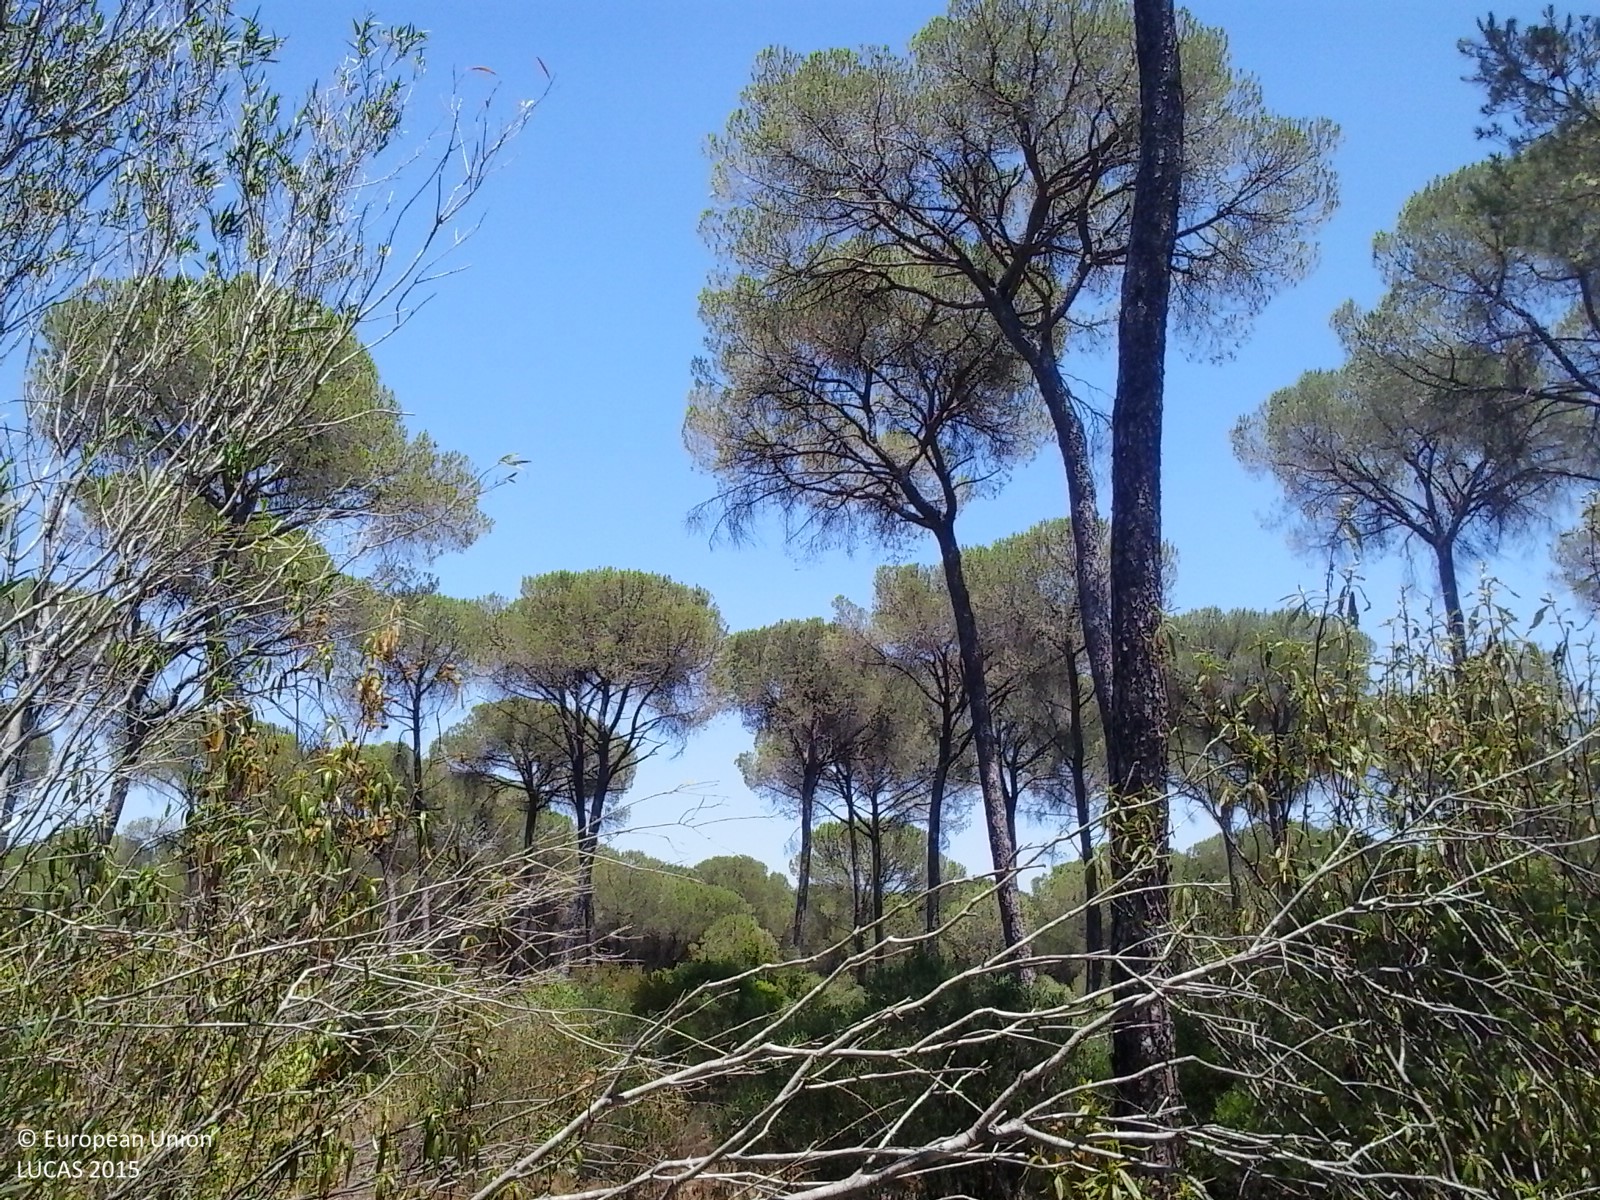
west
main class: Woodland
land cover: Pine dominated coniferous woodland
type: coniferous forest of the mediterranean region
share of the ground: 50 - 75 %
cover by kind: coniferous forest trees 80 %, shrubs 20 %
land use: Forestry
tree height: > 5 m
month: July
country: ES
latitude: 37.2134
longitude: -6.4234
